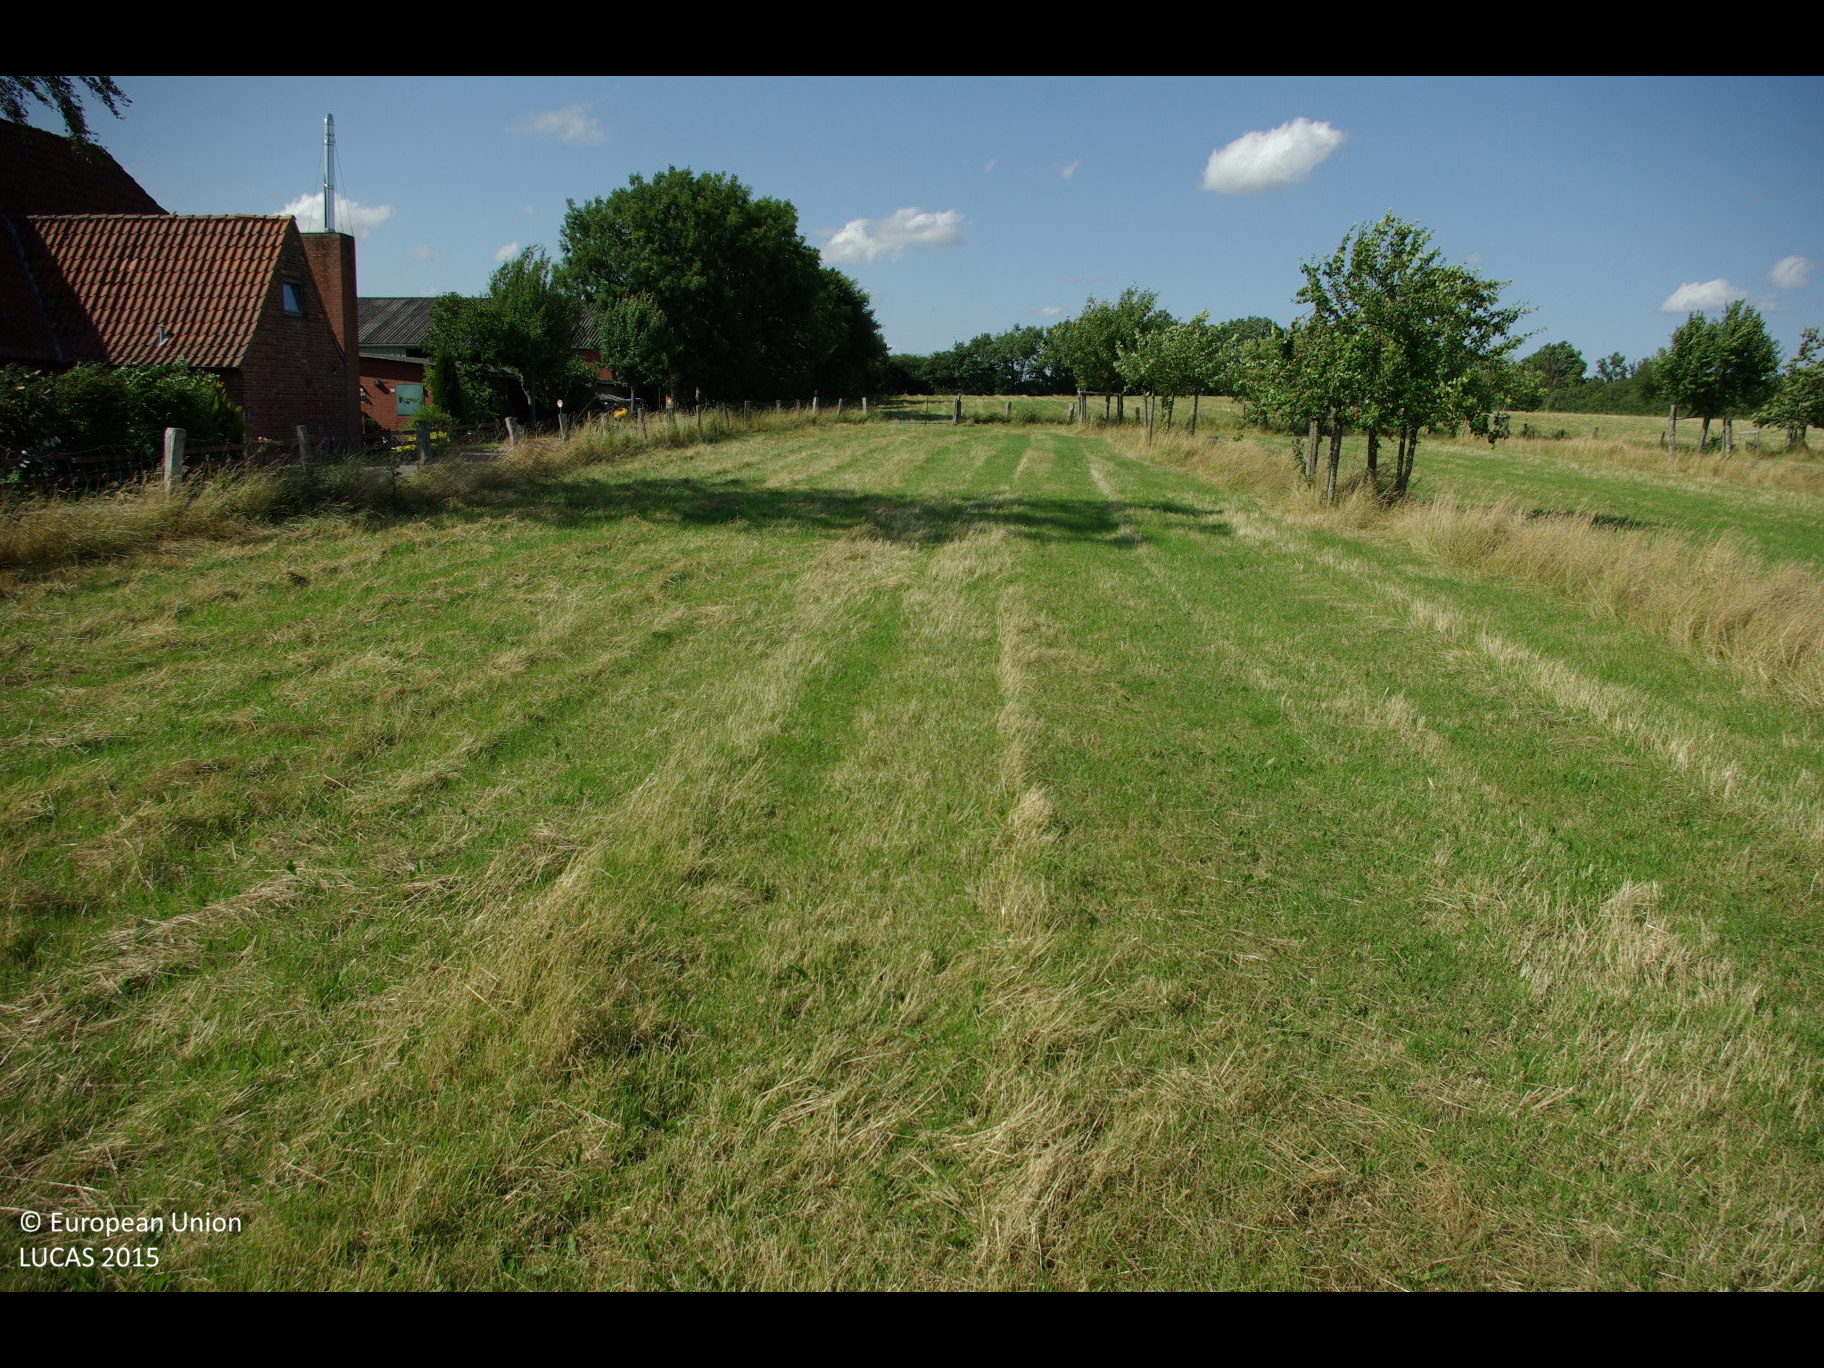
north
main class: Cropland
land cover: Apple fruit
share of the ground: 10 - 25 %
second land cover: Grassland without tree/shrub cover
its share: > 75 %
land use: Agriculture (excluding fallow land and kitchen gardens)
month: July
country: DE
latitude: 54.5881
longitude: 9.9227
